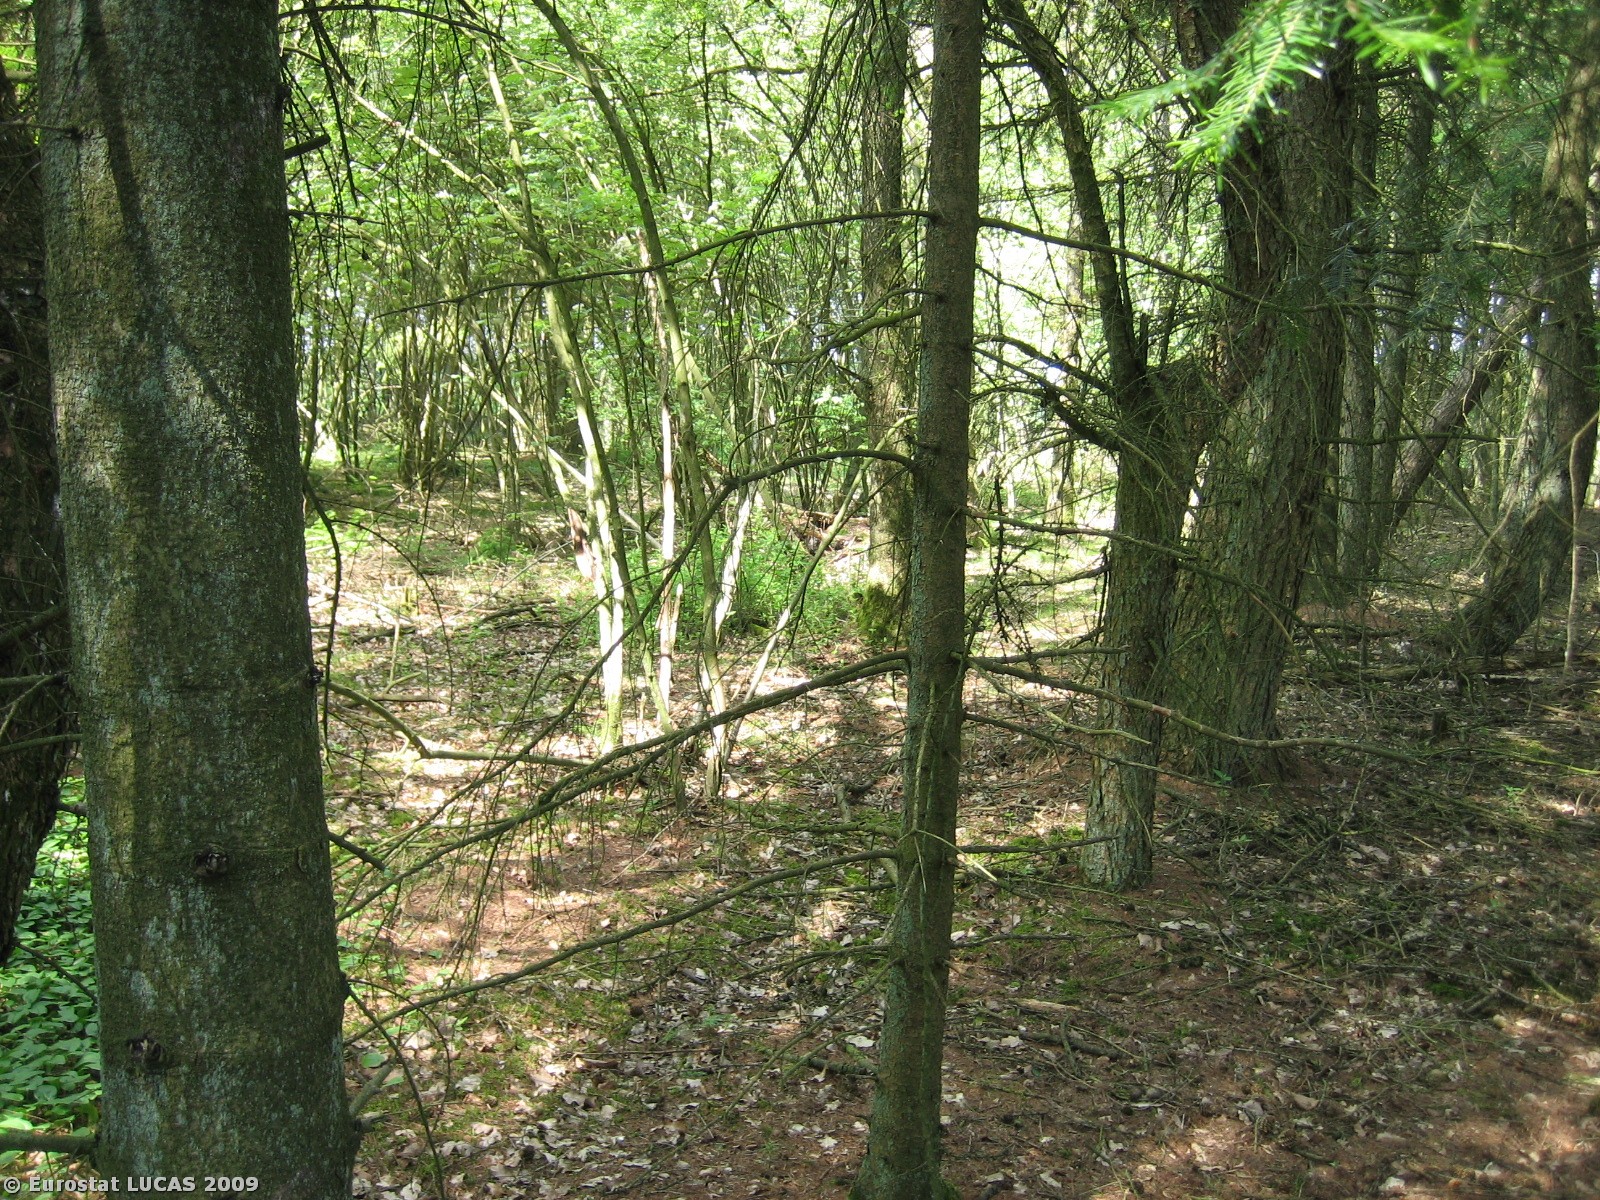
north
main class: Woodland
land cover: Mixed woodland
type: mesophytic deciduous forest
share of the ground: > 75 %
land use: Forestry
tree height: > 5 m
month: May
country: DK
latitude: 56.0954
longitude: 9.2133
